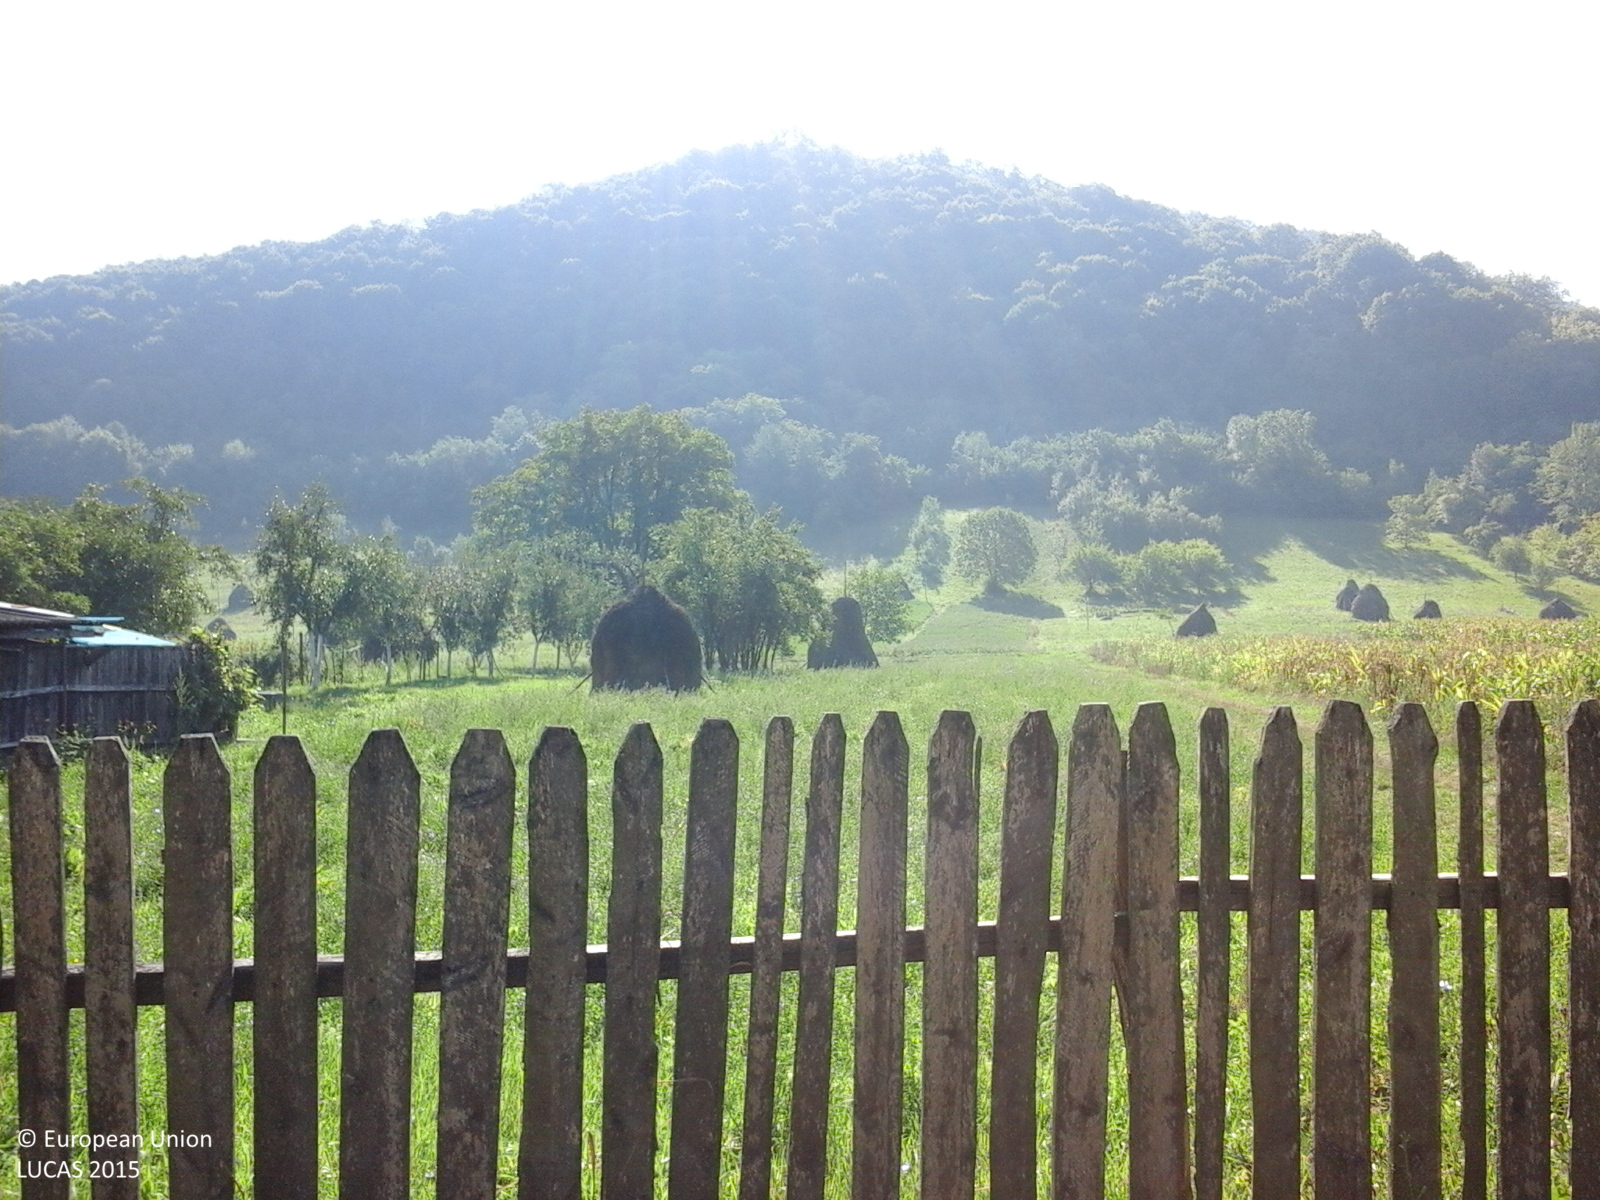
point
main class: Cropland
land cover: Other fruit trees and berries
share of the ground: 25 - 50 %
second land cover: Grassland without tree/shrub cover
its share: > 75 %
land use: Agriculture (excluding fallow land and kitchen gardens)
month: August
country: RO
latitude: 46.2182
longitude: 22.3237
